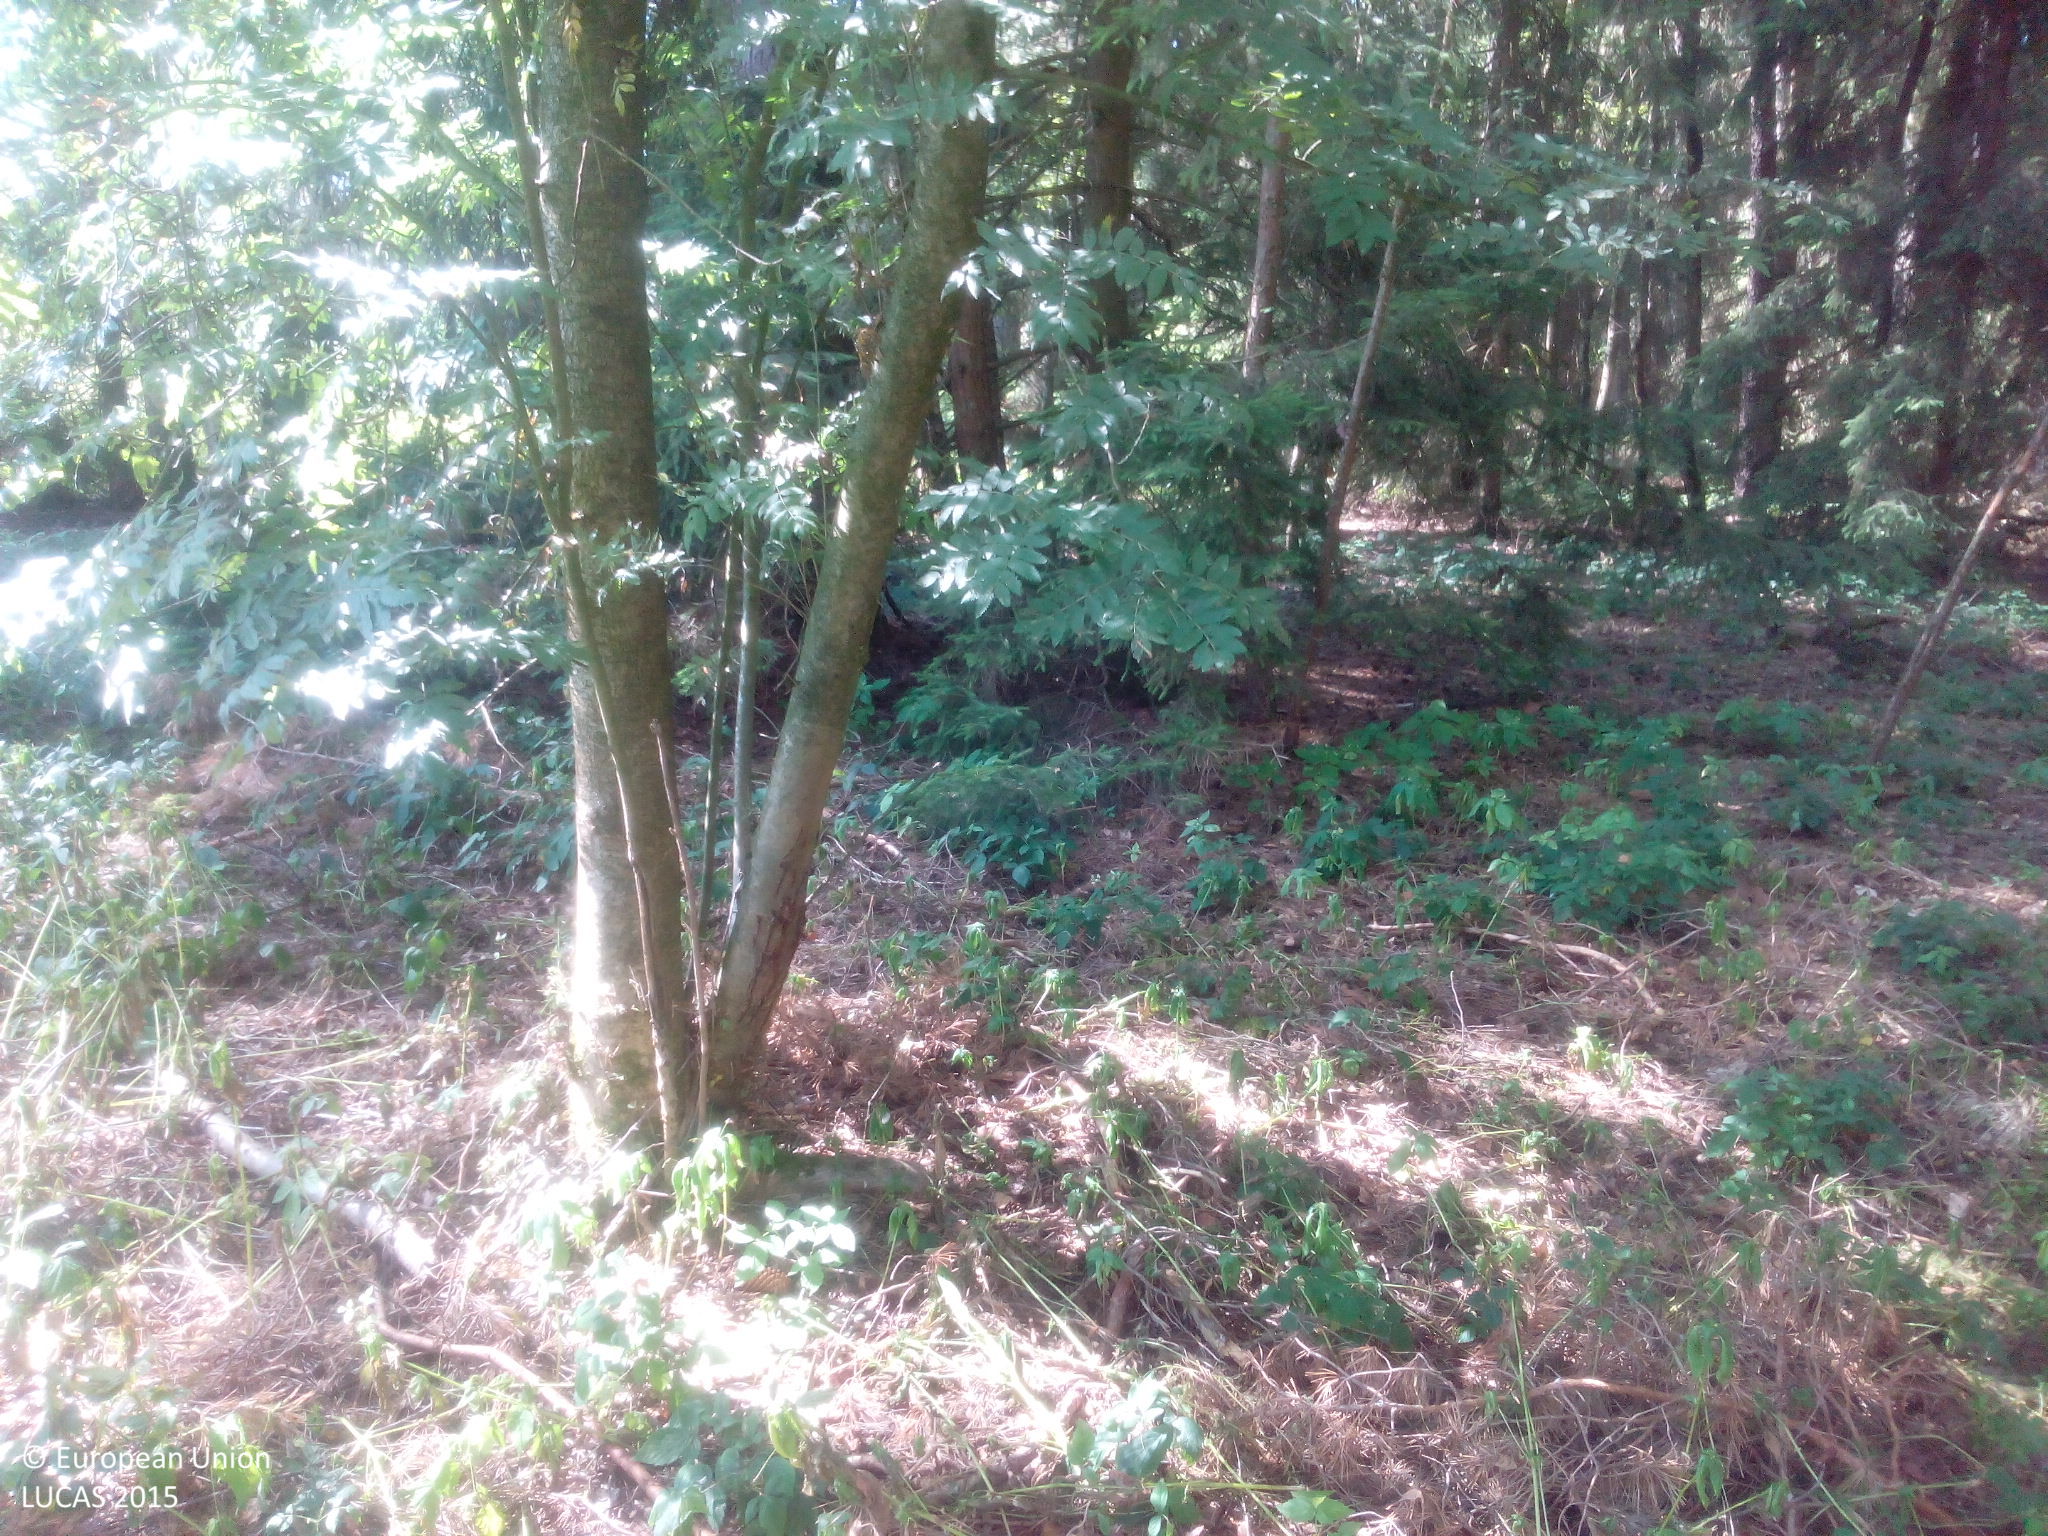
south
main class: Woodland
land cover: Other mixed woodland
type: hemiboreal forest and nemoral coniferous forest and mixed broadleaved-coniferous forest
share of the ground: > 75 %
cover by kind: coniferous forest trees 60 %, broadleaved forest trees 25 %, herbaceous plants 15 %
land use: Forestry
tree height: > 5 m
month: July
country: DE
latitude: 49.3352
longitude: 10.9217
